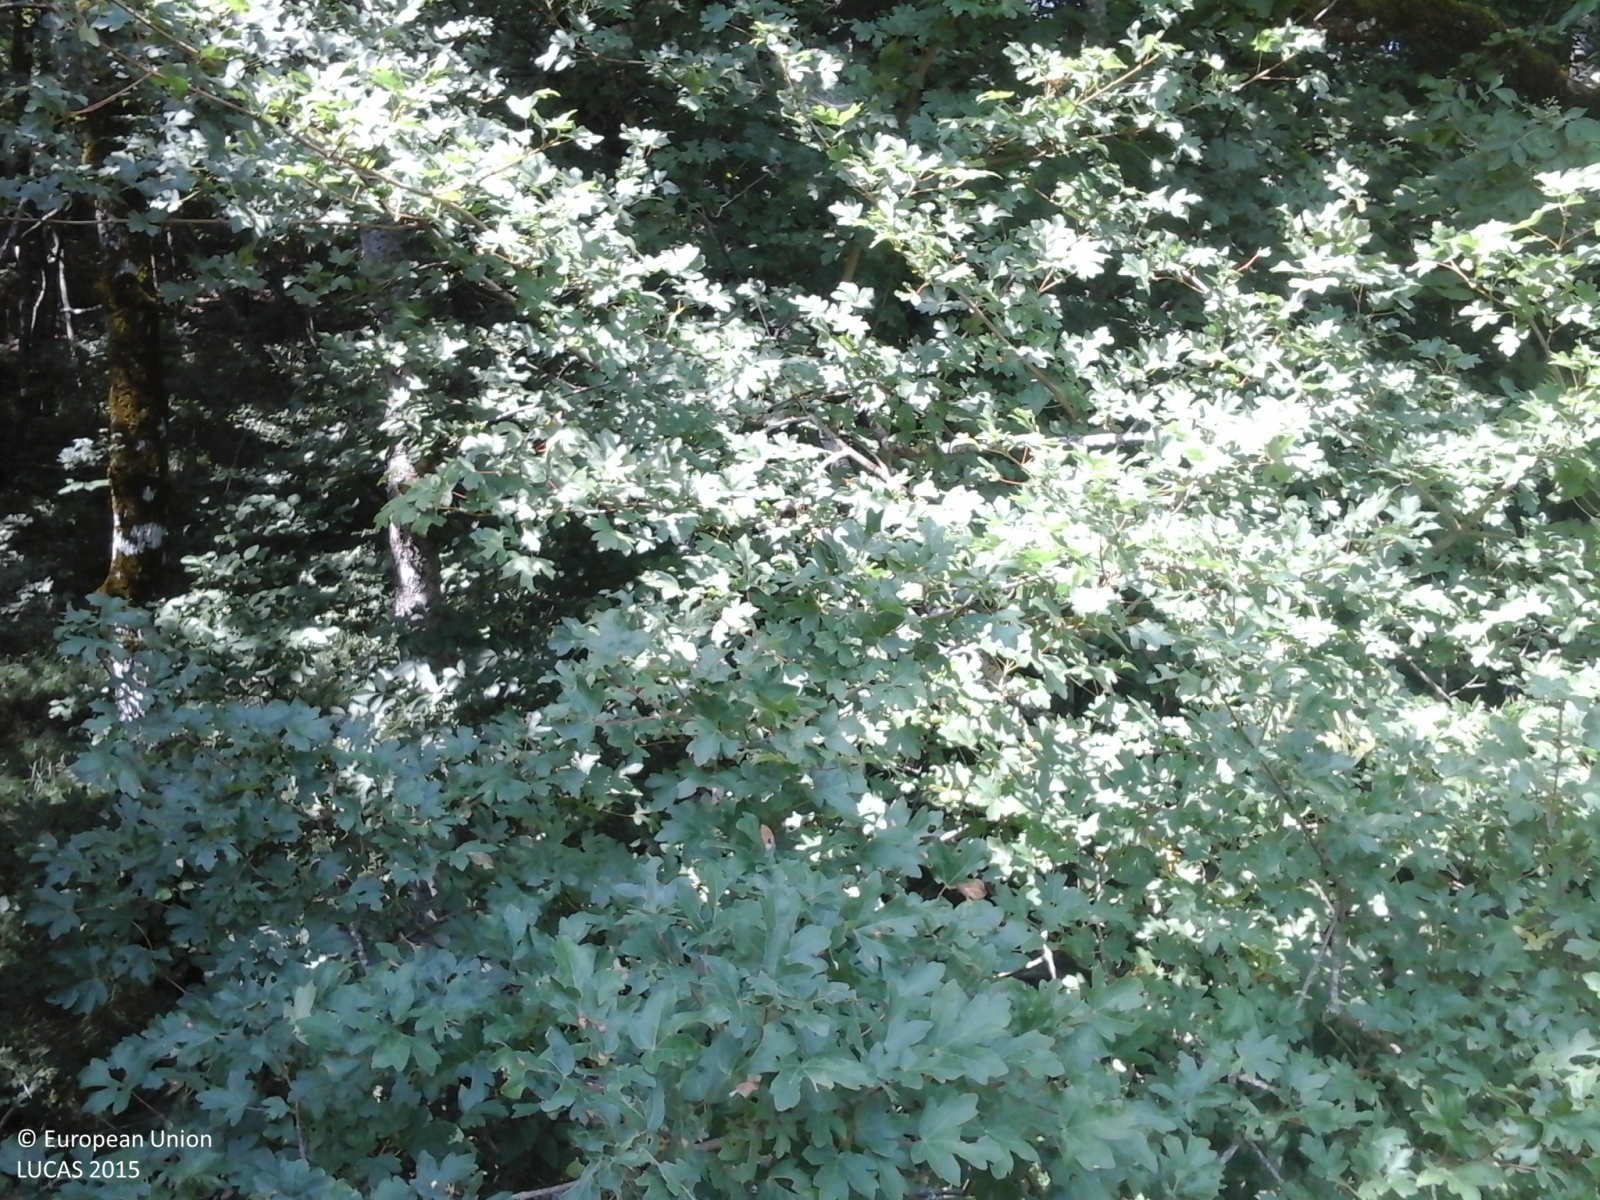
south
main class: Woodland
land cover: Broadleaved woodland
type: thermophilous deciduous forest
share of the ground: > 75 %
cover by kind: broadleaved forest trees 100 %
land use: Forestry
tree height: > 5 m
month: July
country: IT
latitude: 44.4585
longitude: 10.2132
